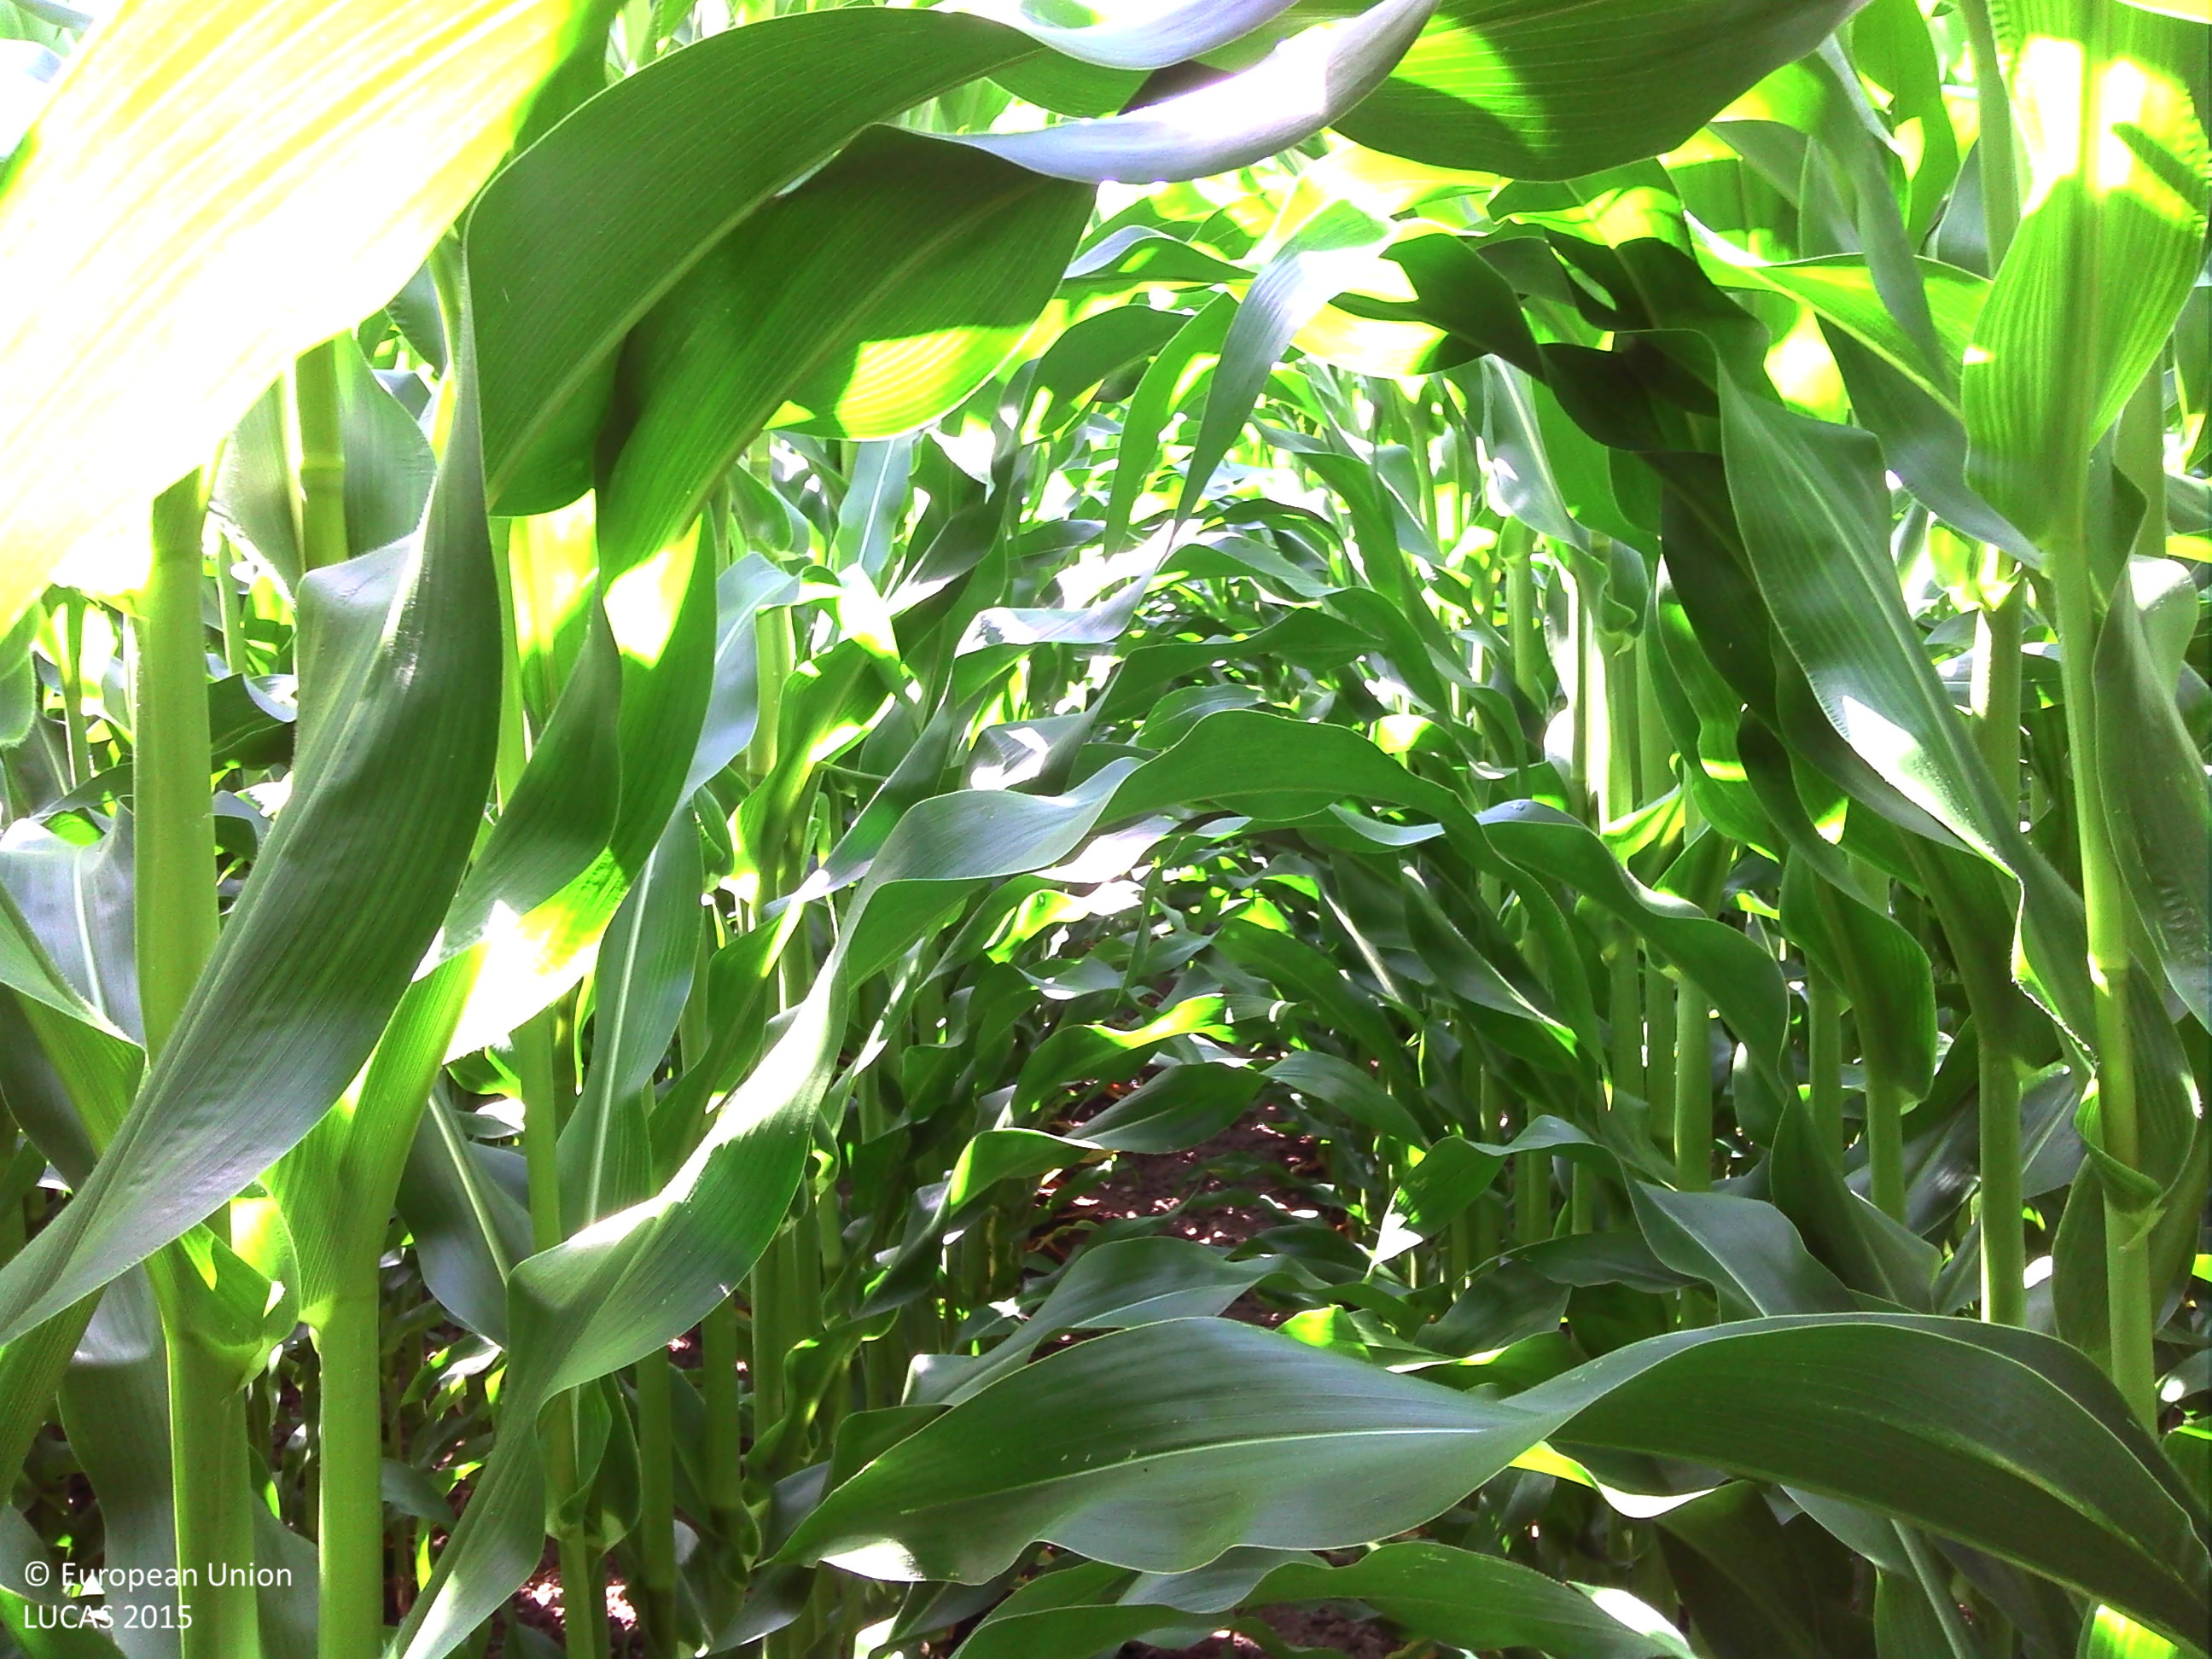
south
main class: Cropland
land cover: Maize
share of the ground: > 75 %
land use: Agriculture (excluding fallow land and kitchen gardens)
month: July
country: FR
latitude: 47.8184
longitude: -3.1175
